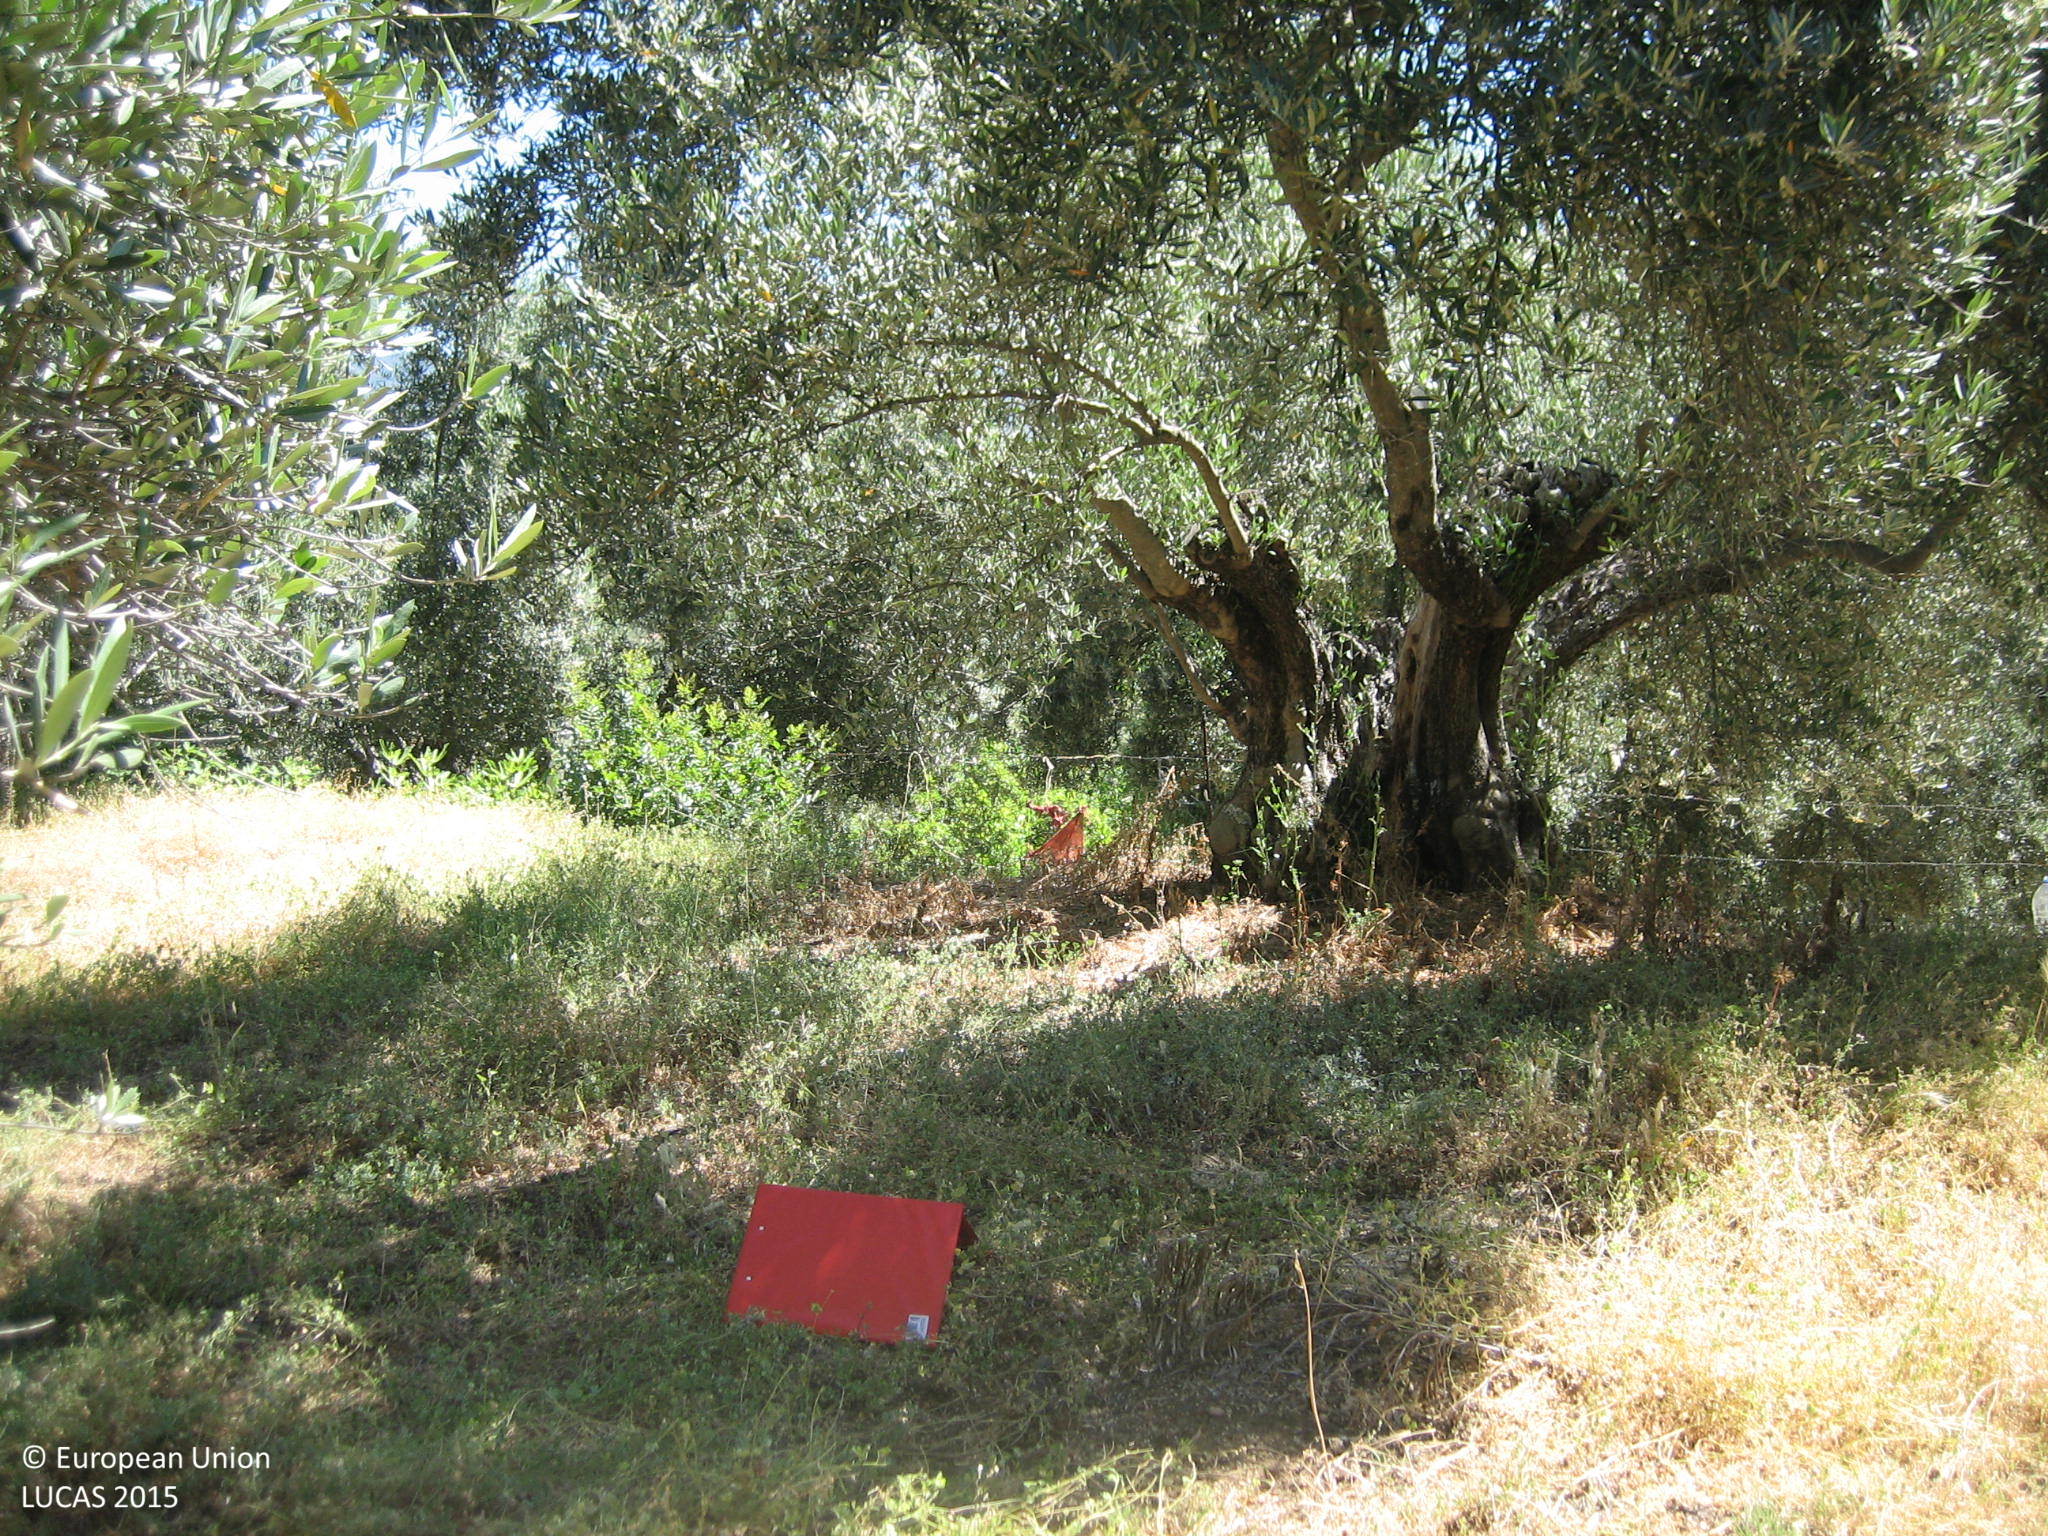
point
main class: Cropland
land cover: Olive groves
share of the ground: 50 - 75 %
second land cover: Grassland without tree/shrub cover
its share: 50 - 75 %
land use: Agriculture (excluding fallow land and kitchen gardens)
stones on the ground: < 10 %
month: May
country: ES
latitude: 38.3857
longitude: -3.9443
